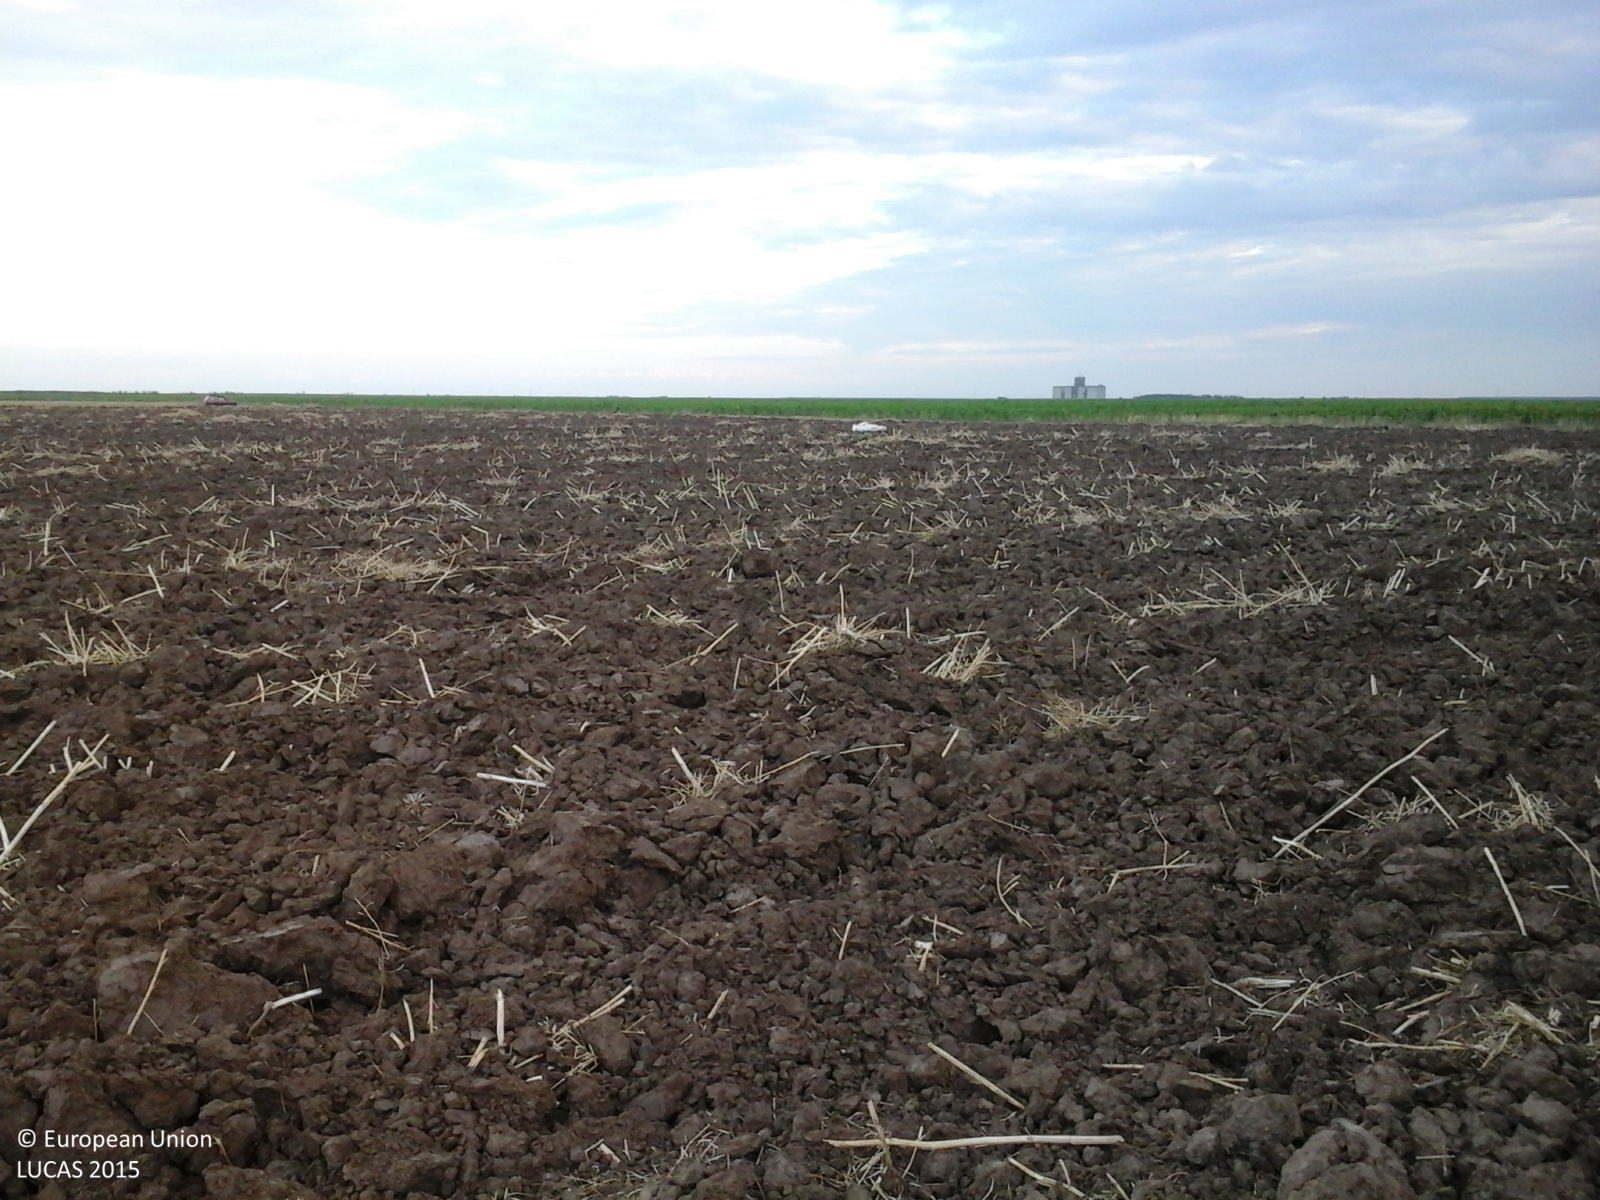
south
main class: Cropland
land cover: Rape and turnip rape
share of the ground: < 10 %
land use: Agriculture (excluding fallow land and kitchen gardens)
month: July
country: RO
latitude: 44.2136
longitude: 25.3168
